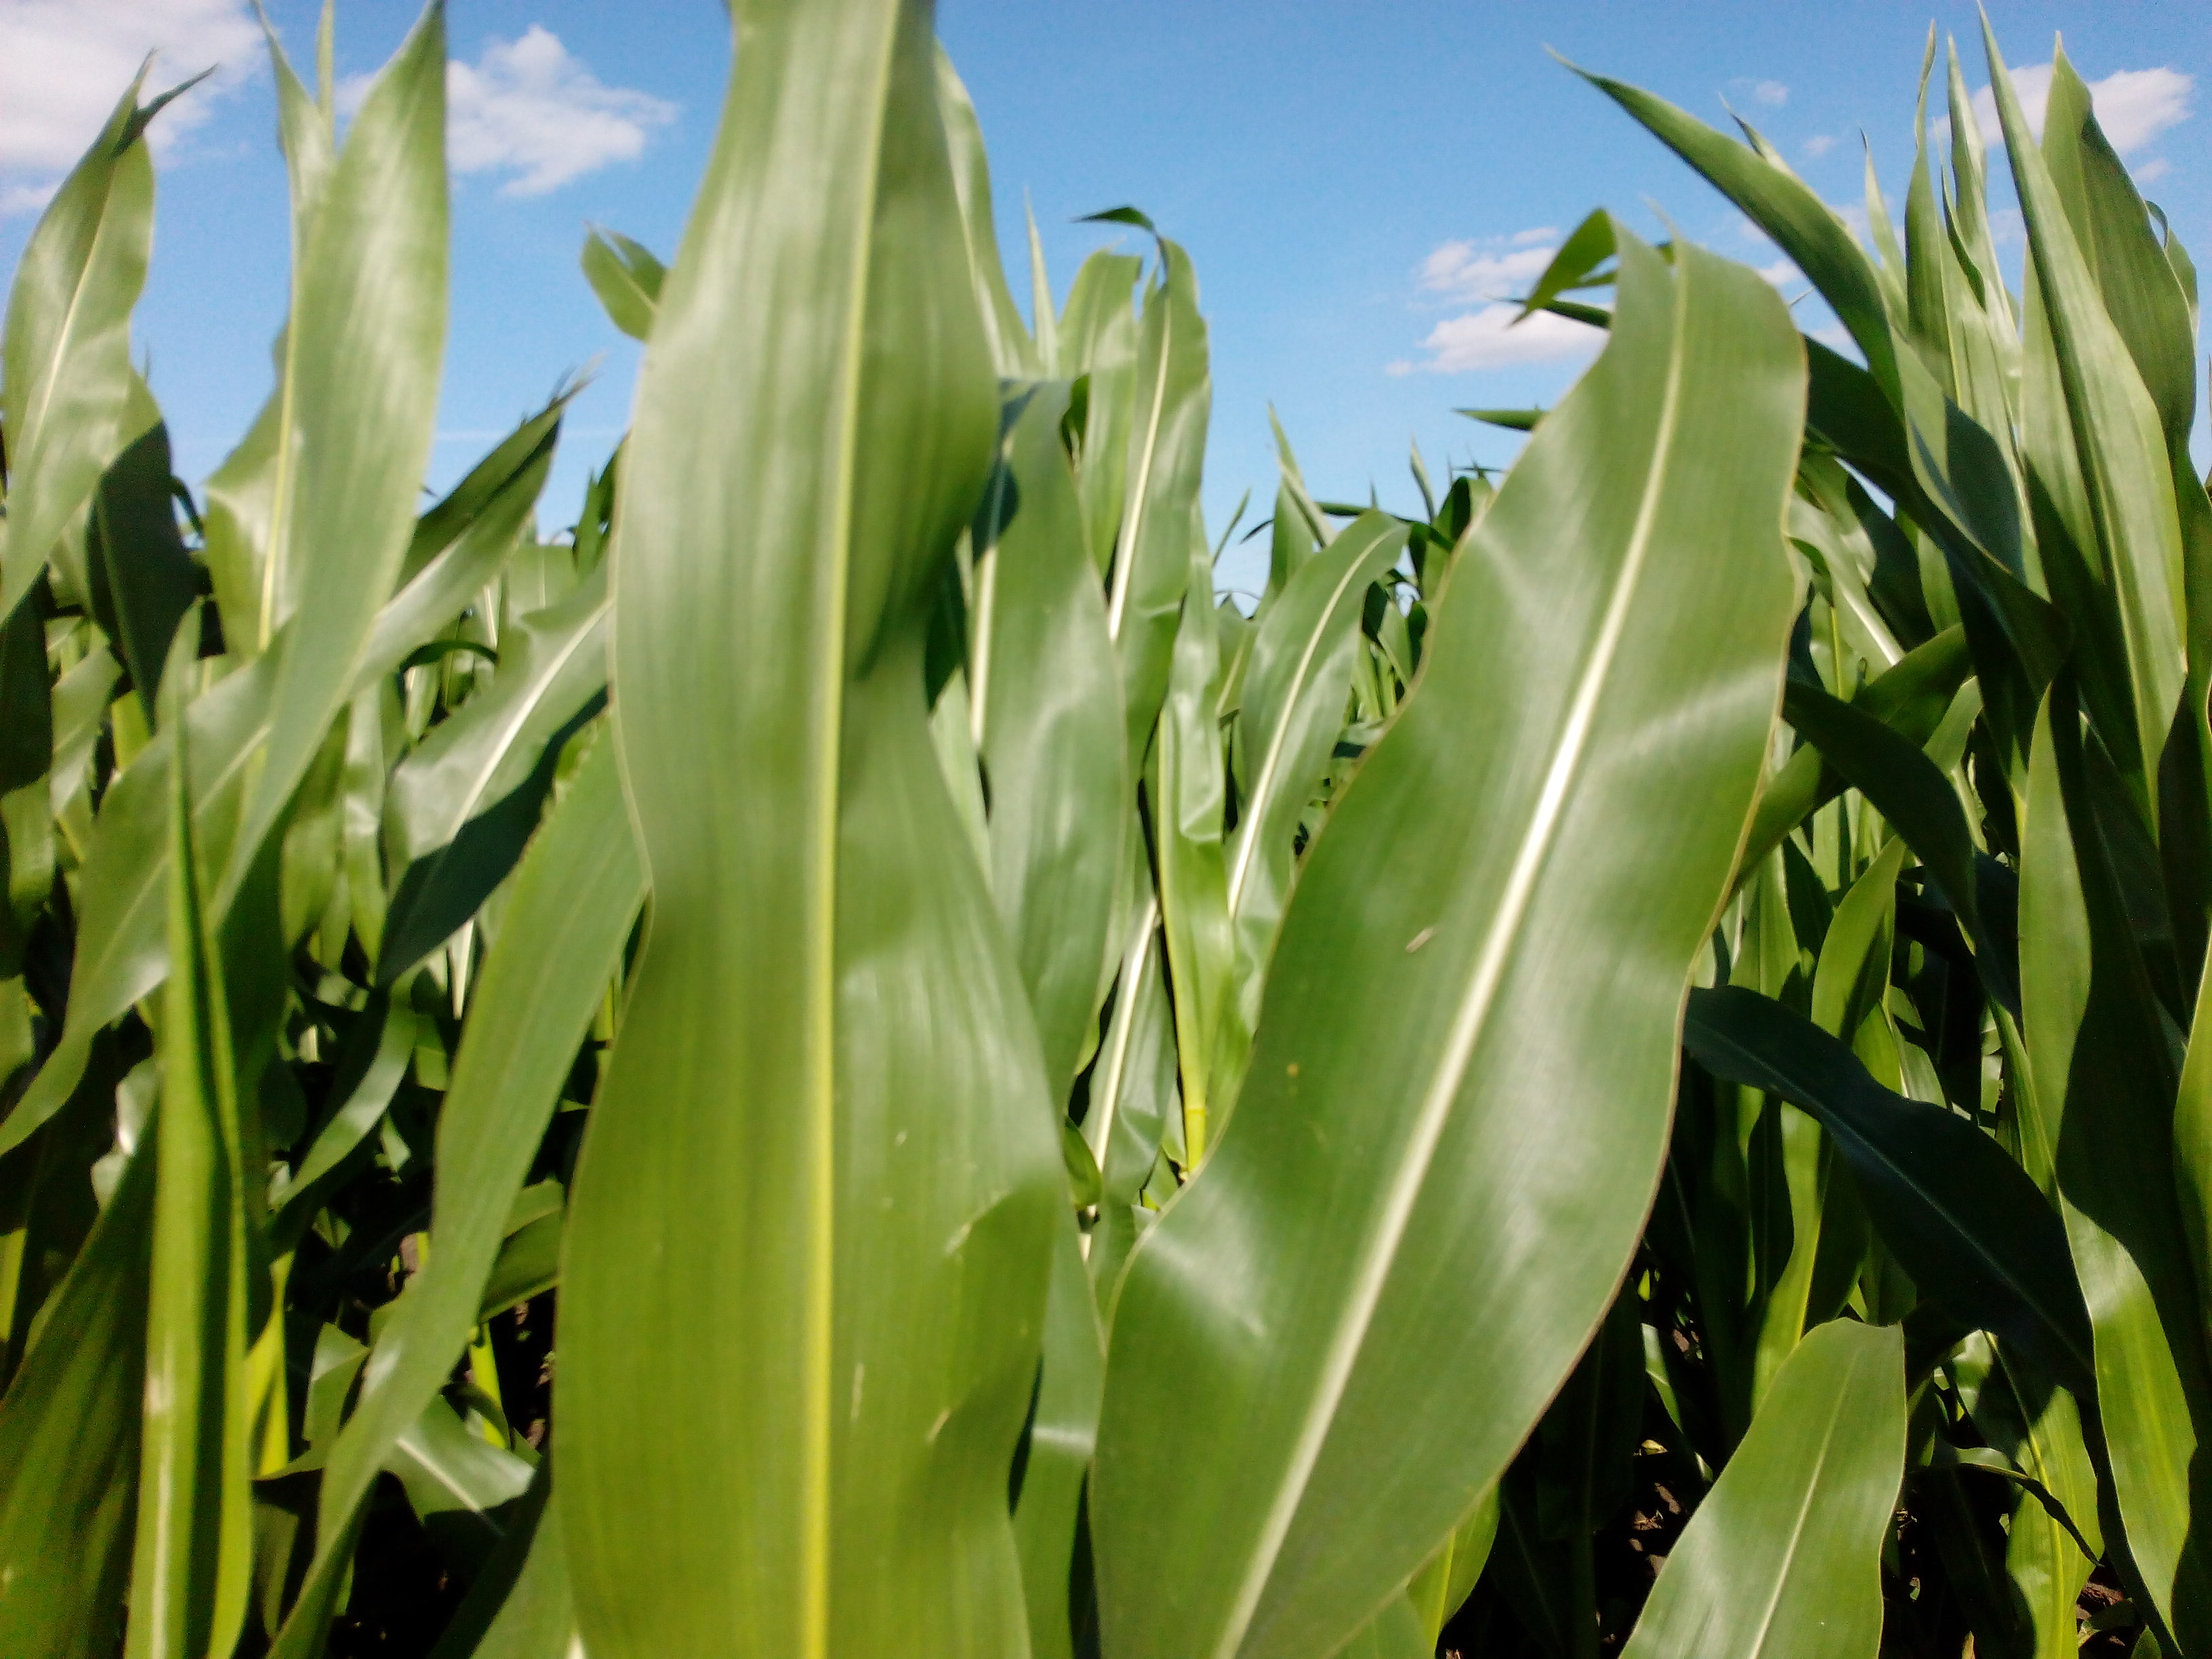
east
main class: Cropland
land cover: Maize
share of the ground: > 75 %
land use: Agriculture (excluding fallow land and kitchen gardens)
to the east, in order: Maize; Grass margins; Tracks; Grass margins; Common wheat
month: July
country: DE
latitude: 51.0963
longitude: 11.0707
